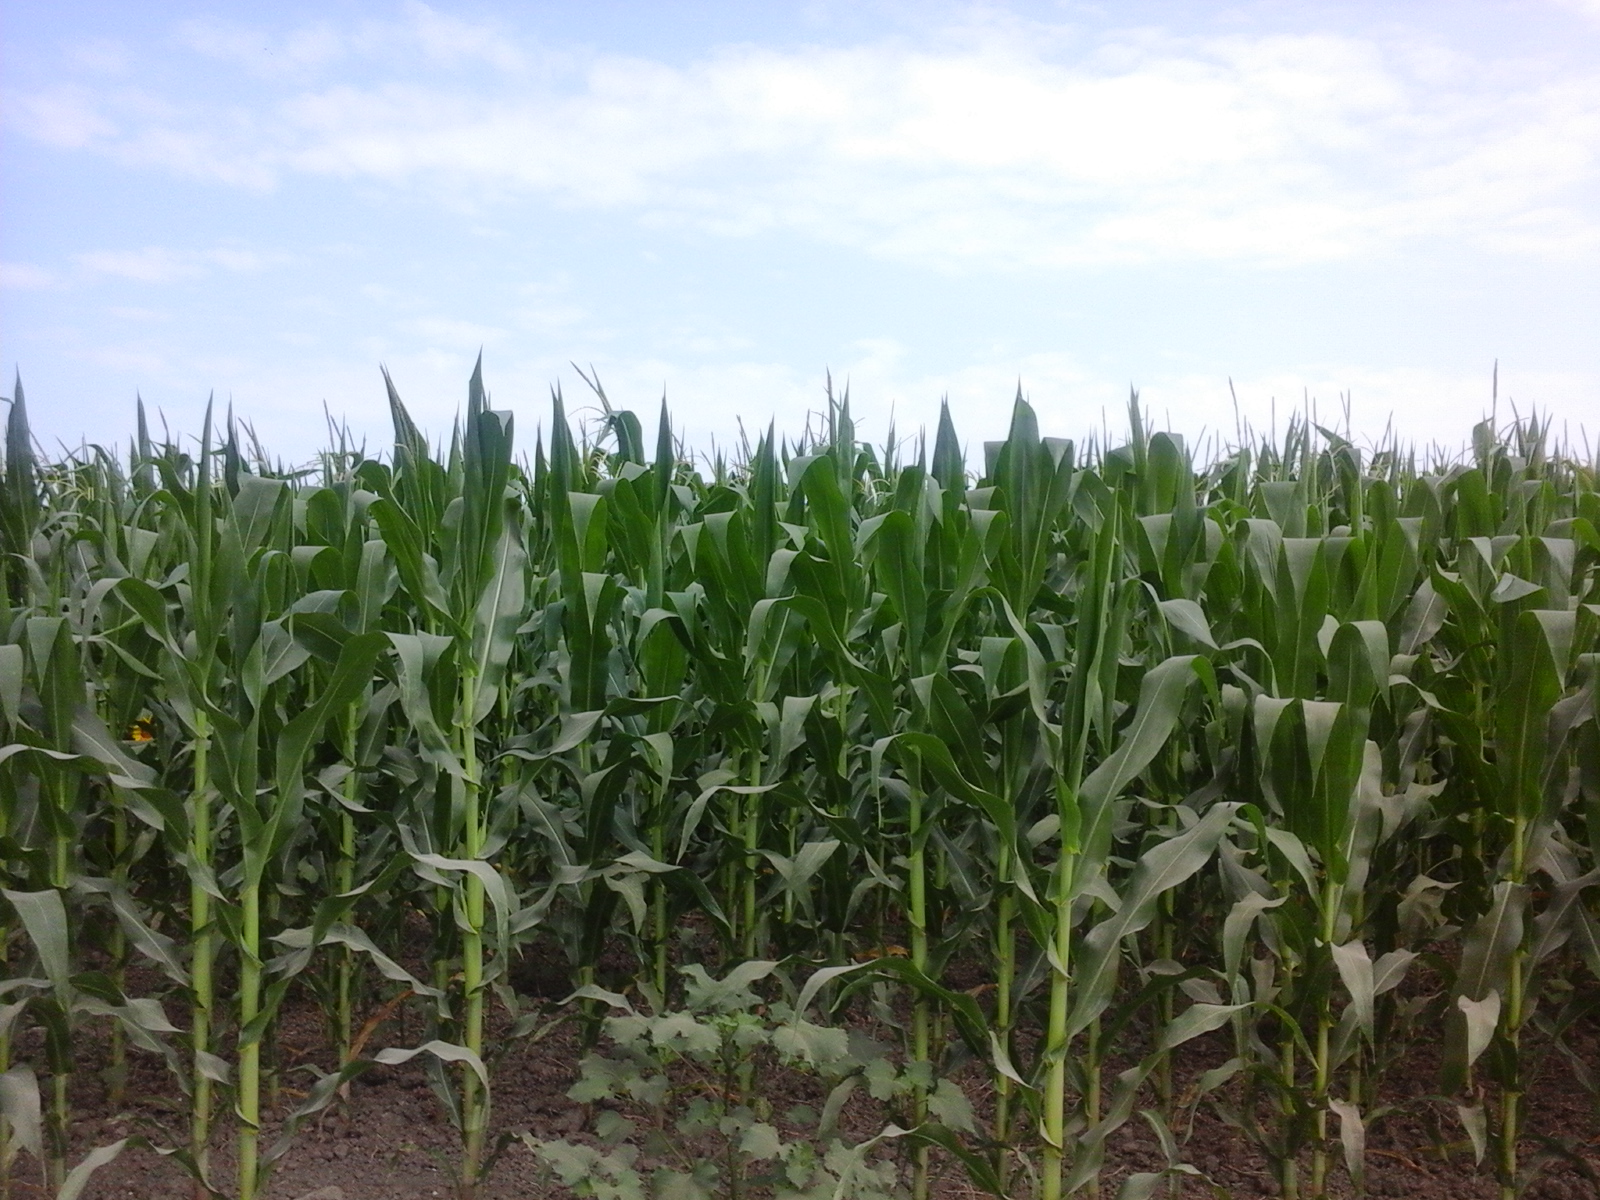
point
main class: Cropland
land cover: Maize
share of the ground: > 75 %
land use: Agriculture (excluding fallow land and kitchen gardens)
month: July
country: RO
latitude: 44.4677
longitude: 28.0461
